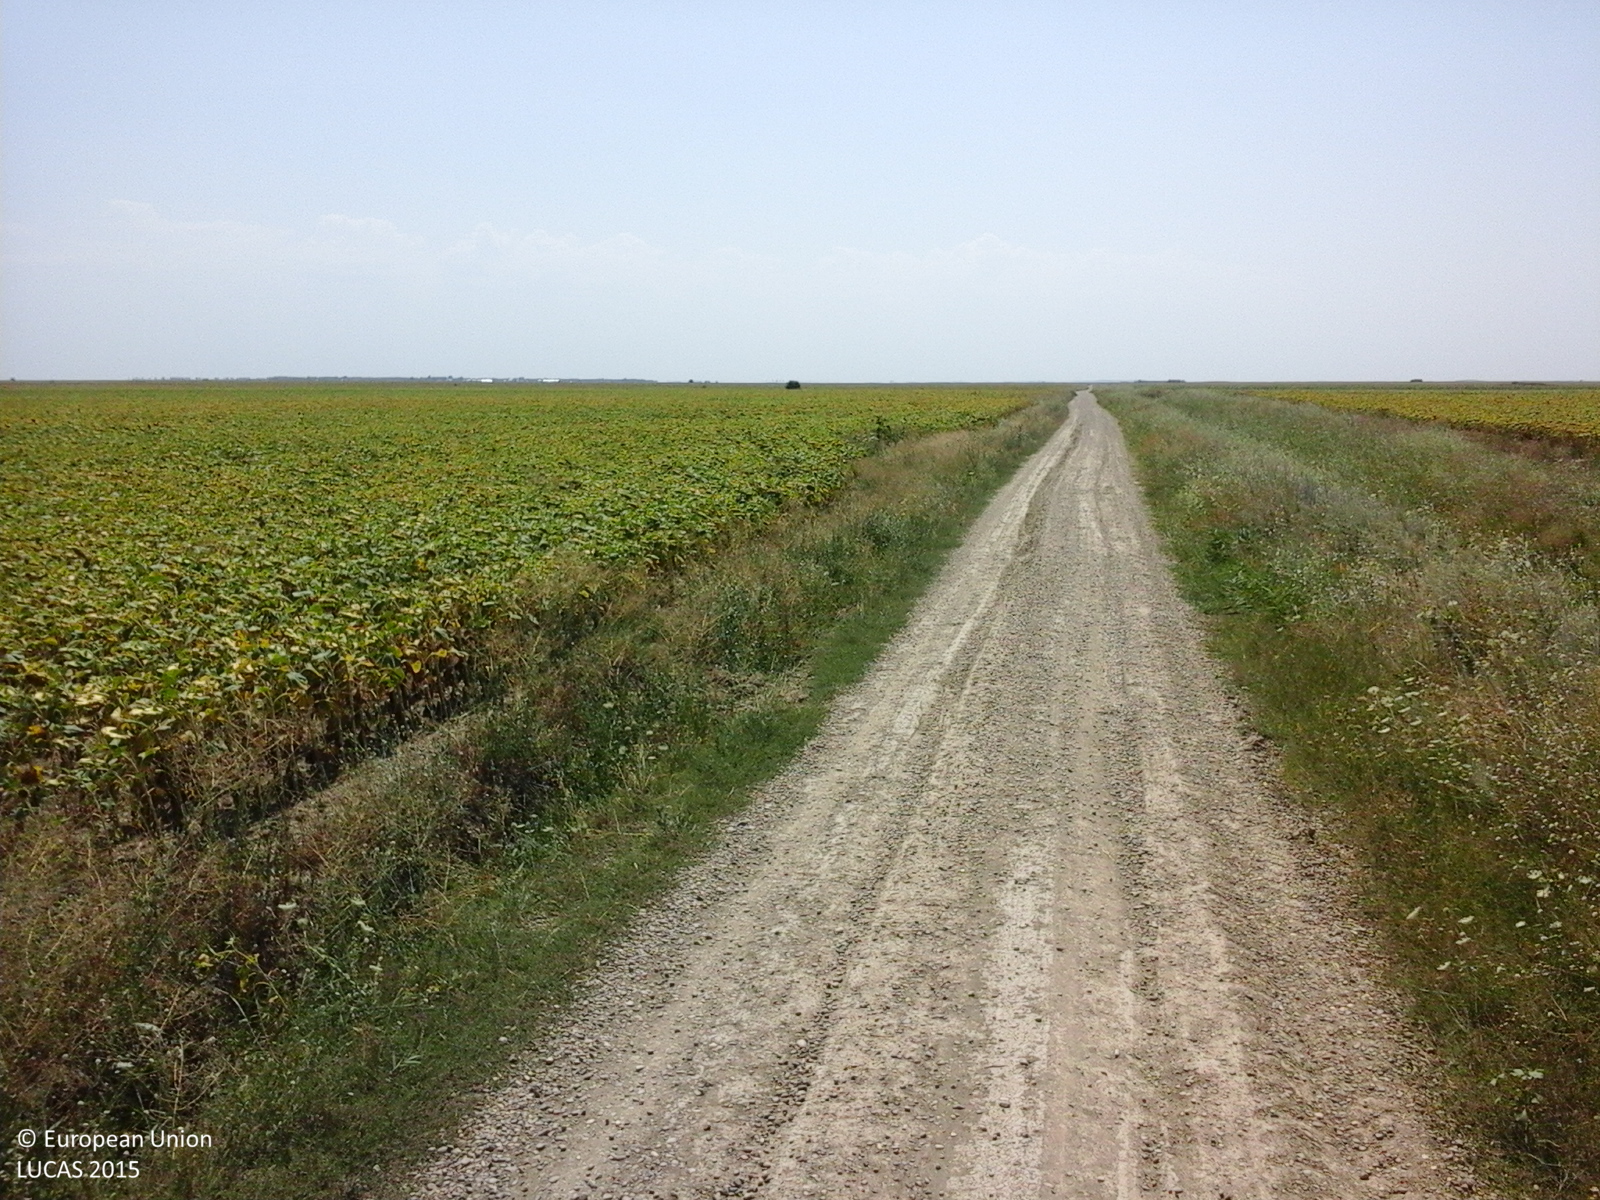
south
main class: Cropland
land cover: Sunflower
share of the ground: > 75 %
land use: Agriculture (excluding fallow land and kitchen gardens)
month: August
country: RO
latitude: 45.4940
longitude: 27.5450
